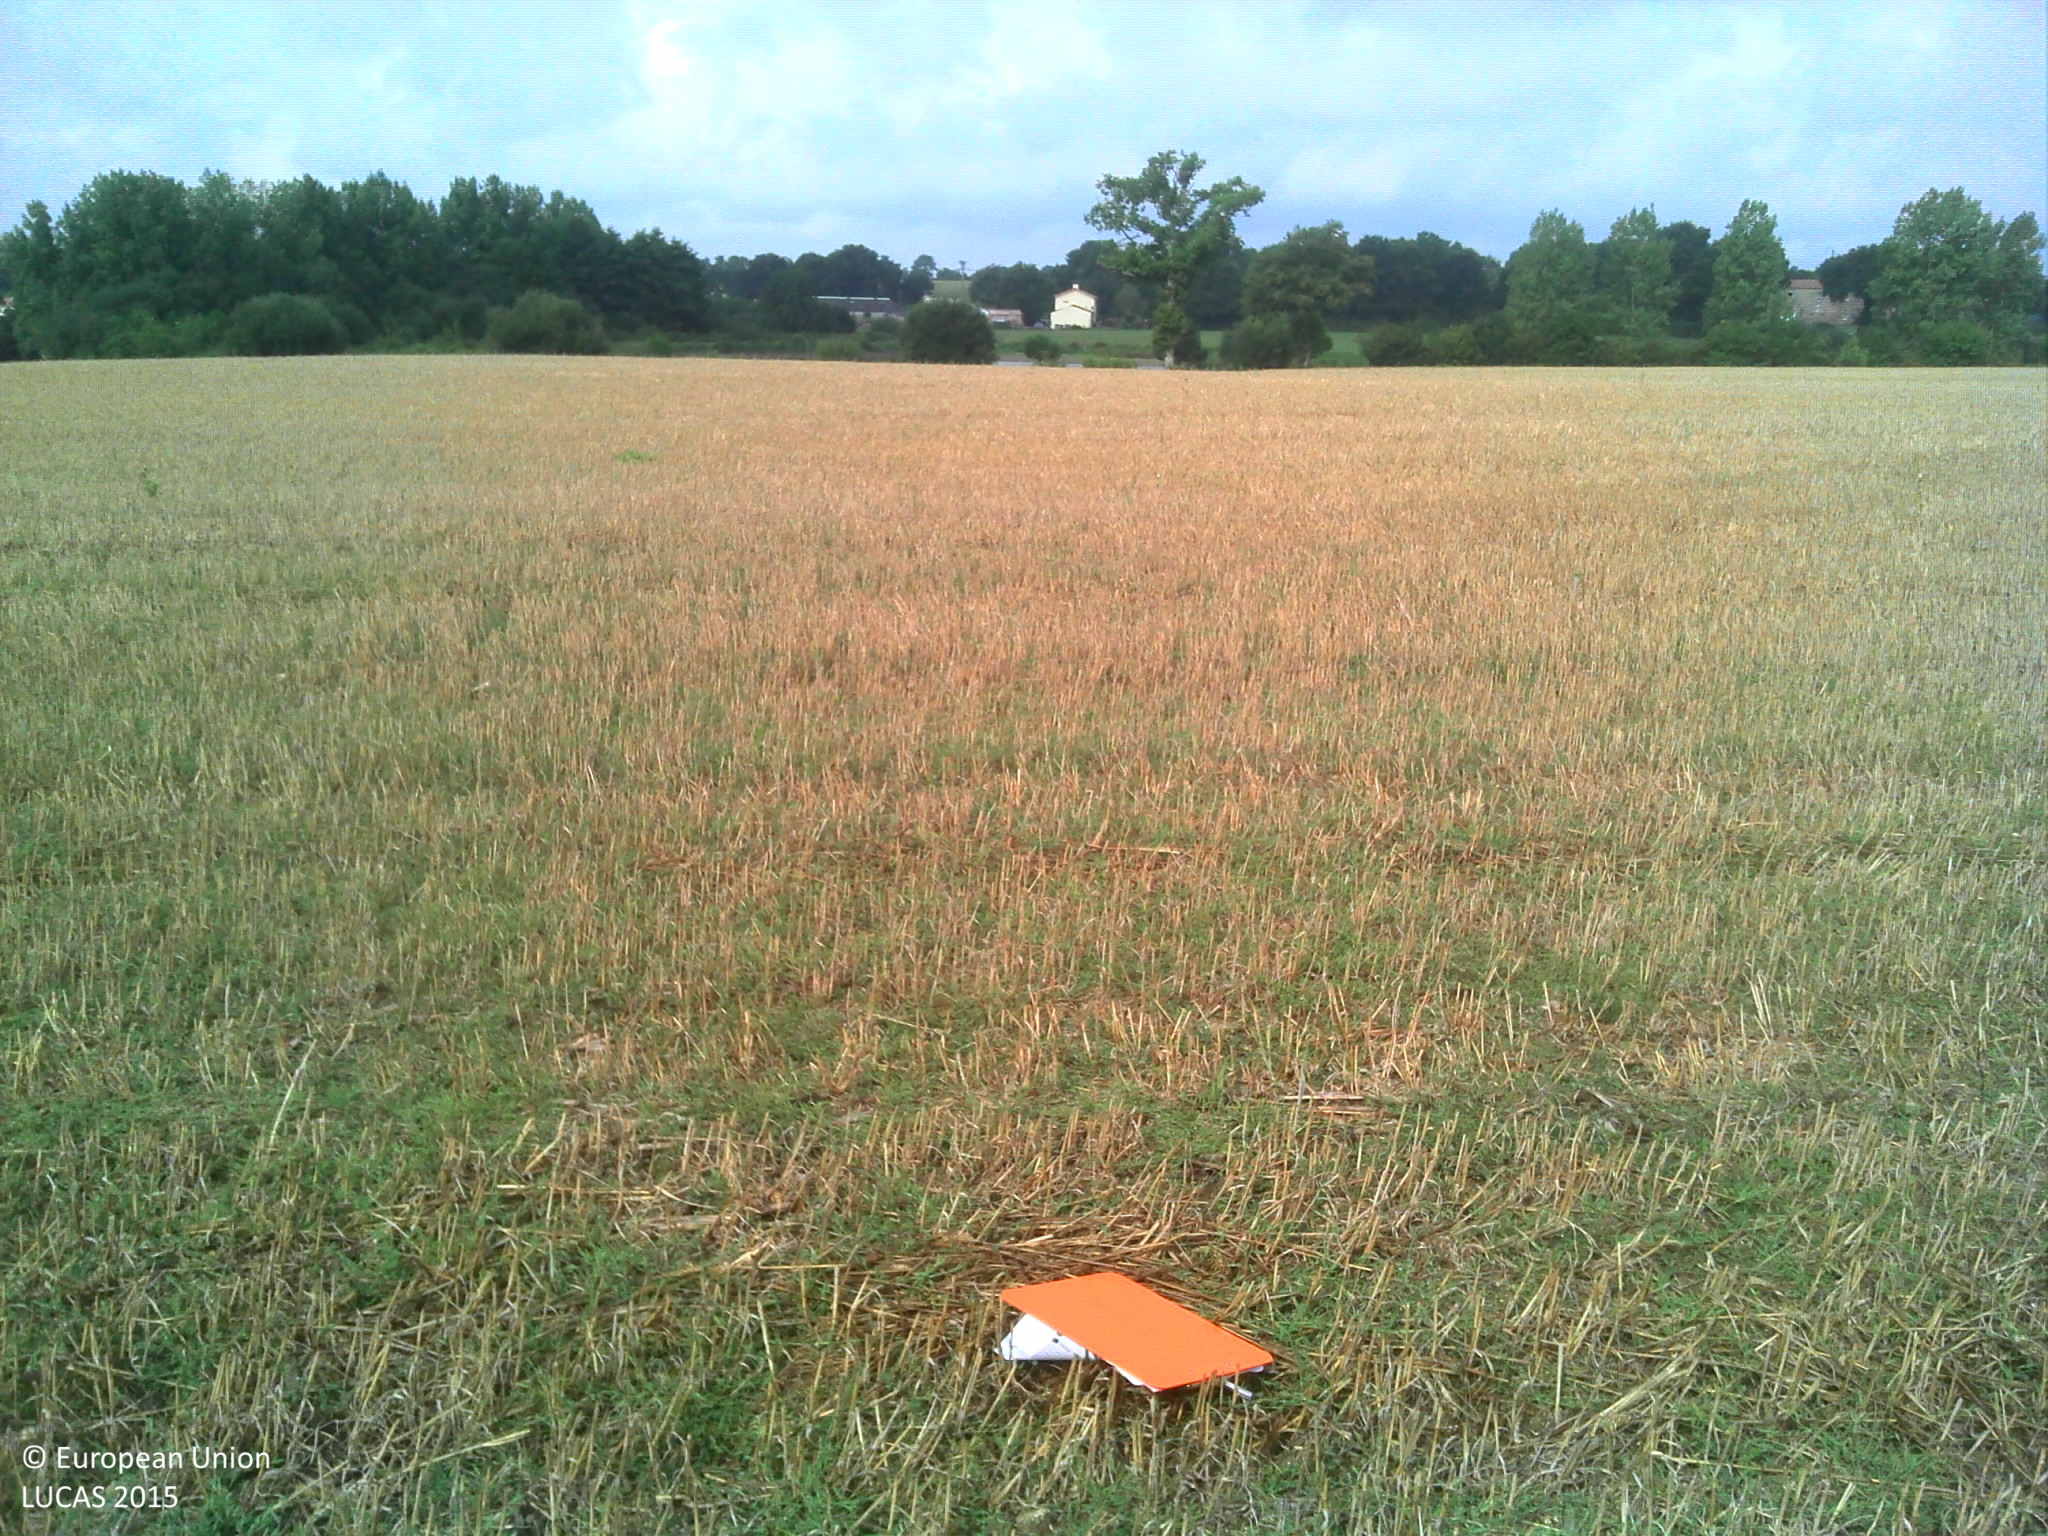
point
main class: Cropland
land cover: Barley
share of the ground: > 75 %
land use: Agriculture (excluding fallow land and kitchen gardens)
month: August
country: FR
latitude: 46.6656
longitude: -1.5804
